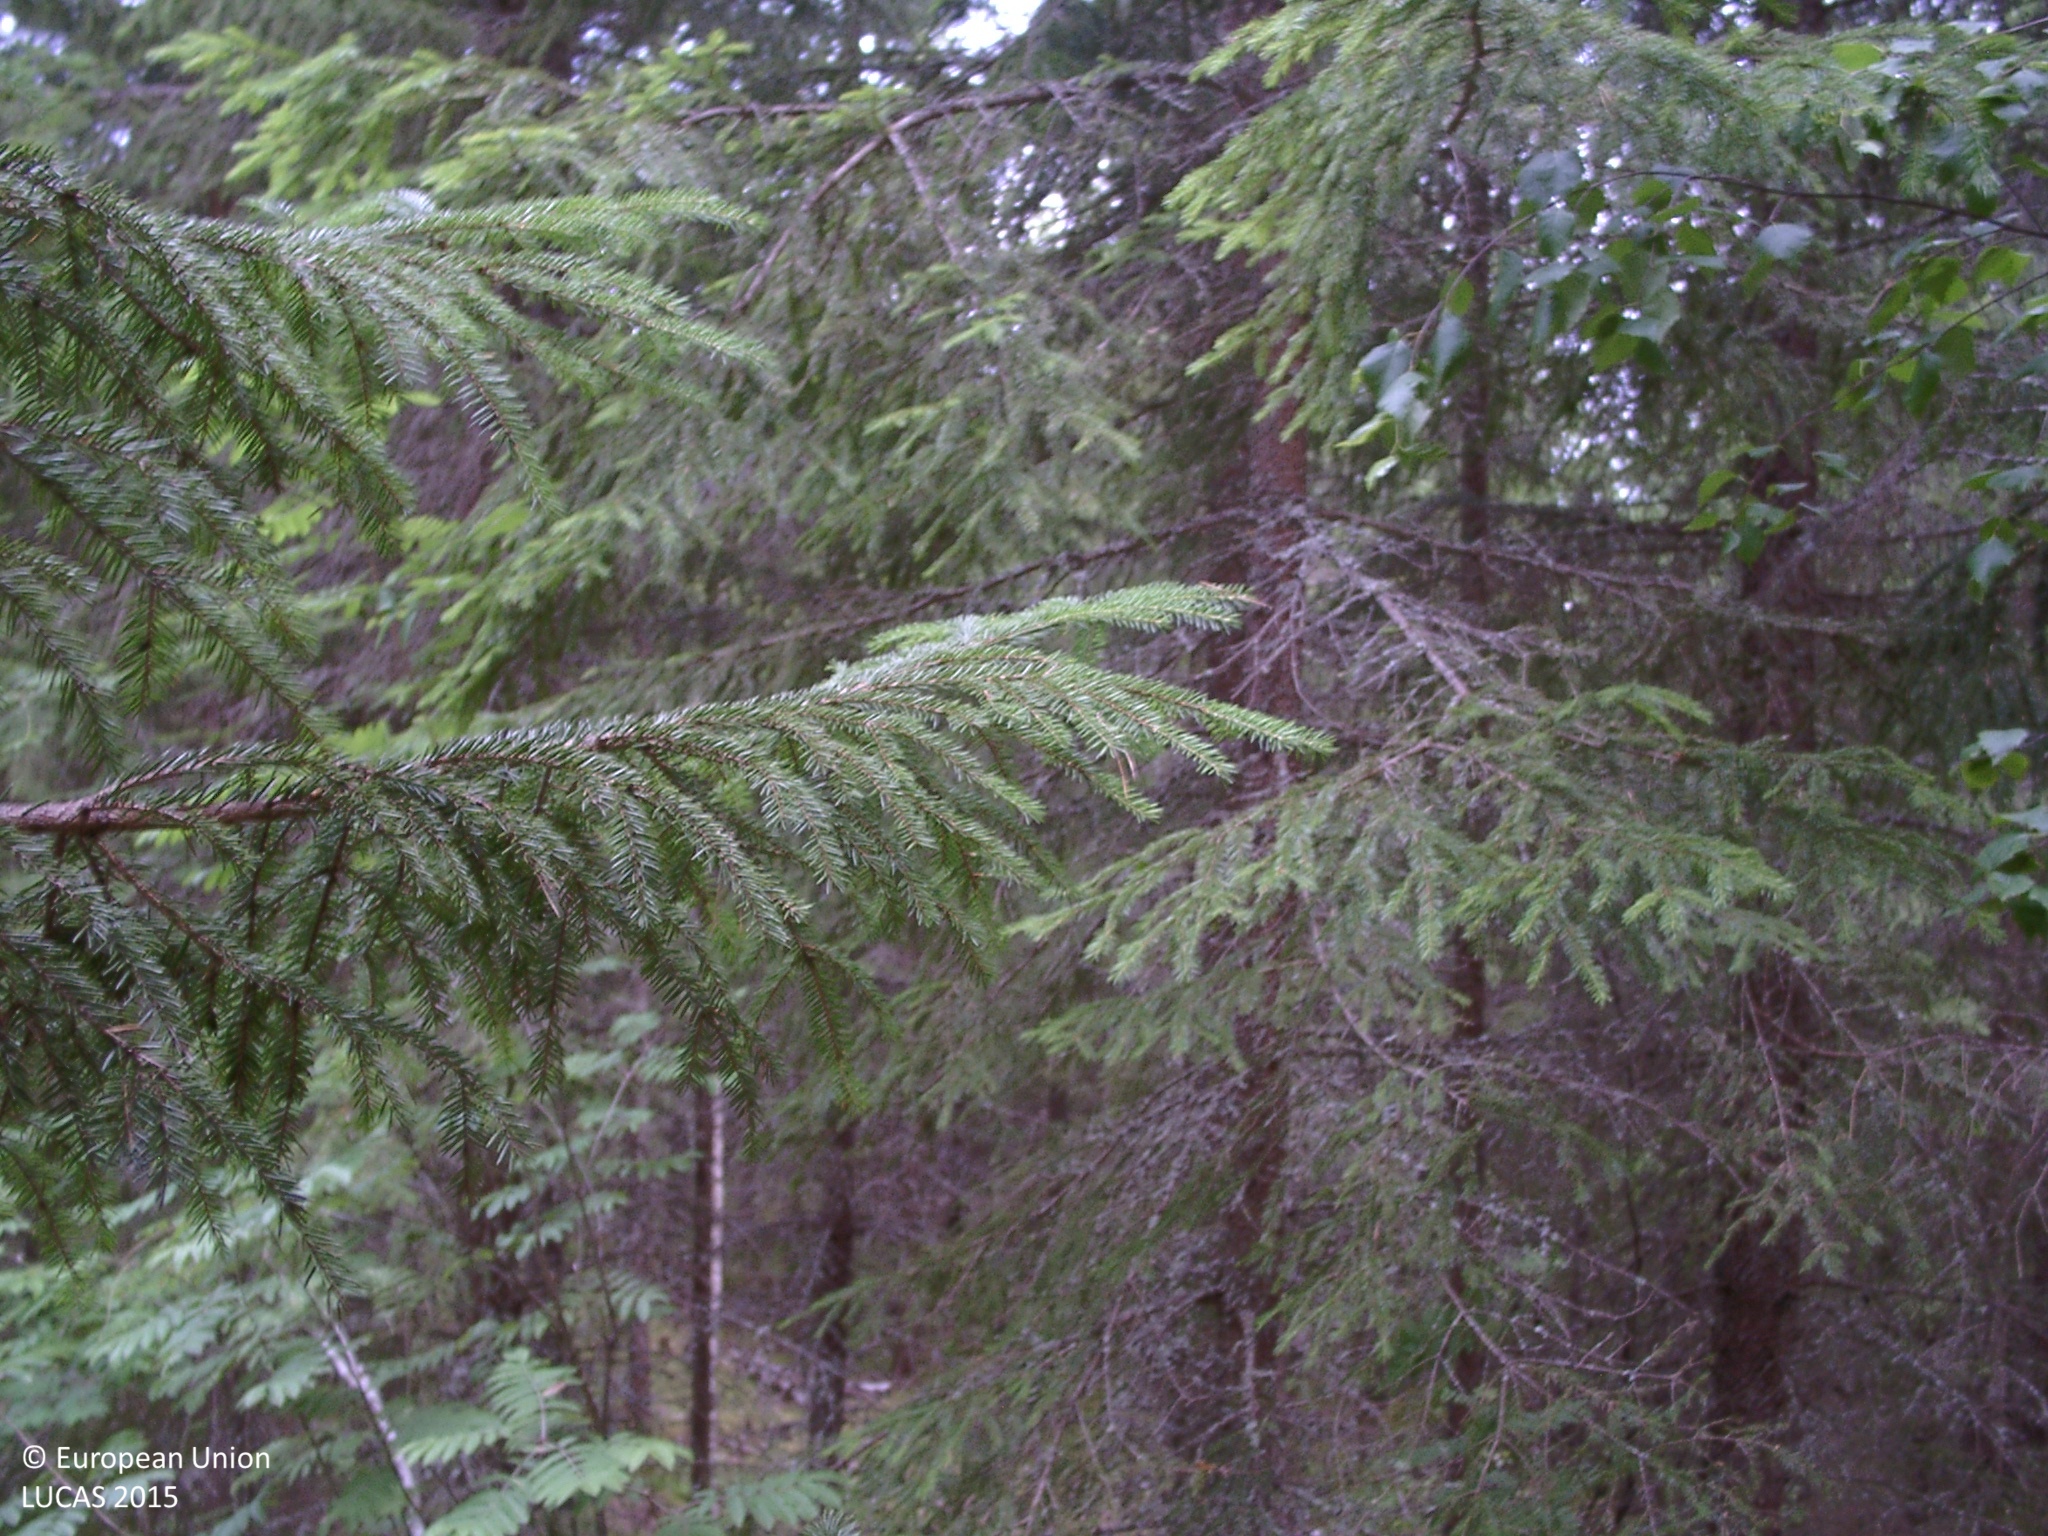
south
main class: Woodland
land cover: Pine dominated mixed woodland
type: boreal forest
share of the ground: 50 - 75 %
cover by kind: coniferous forest trees 45 %, broadleaved forest trees 25 %, herbaceous plants 10 %, lichens and mosses 10 %, shrubs 5 %, consolidated bare surface 5 %
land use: Forestry
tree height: > 5 m
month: July
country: FI
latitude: 61.7734
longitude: 24.7137
